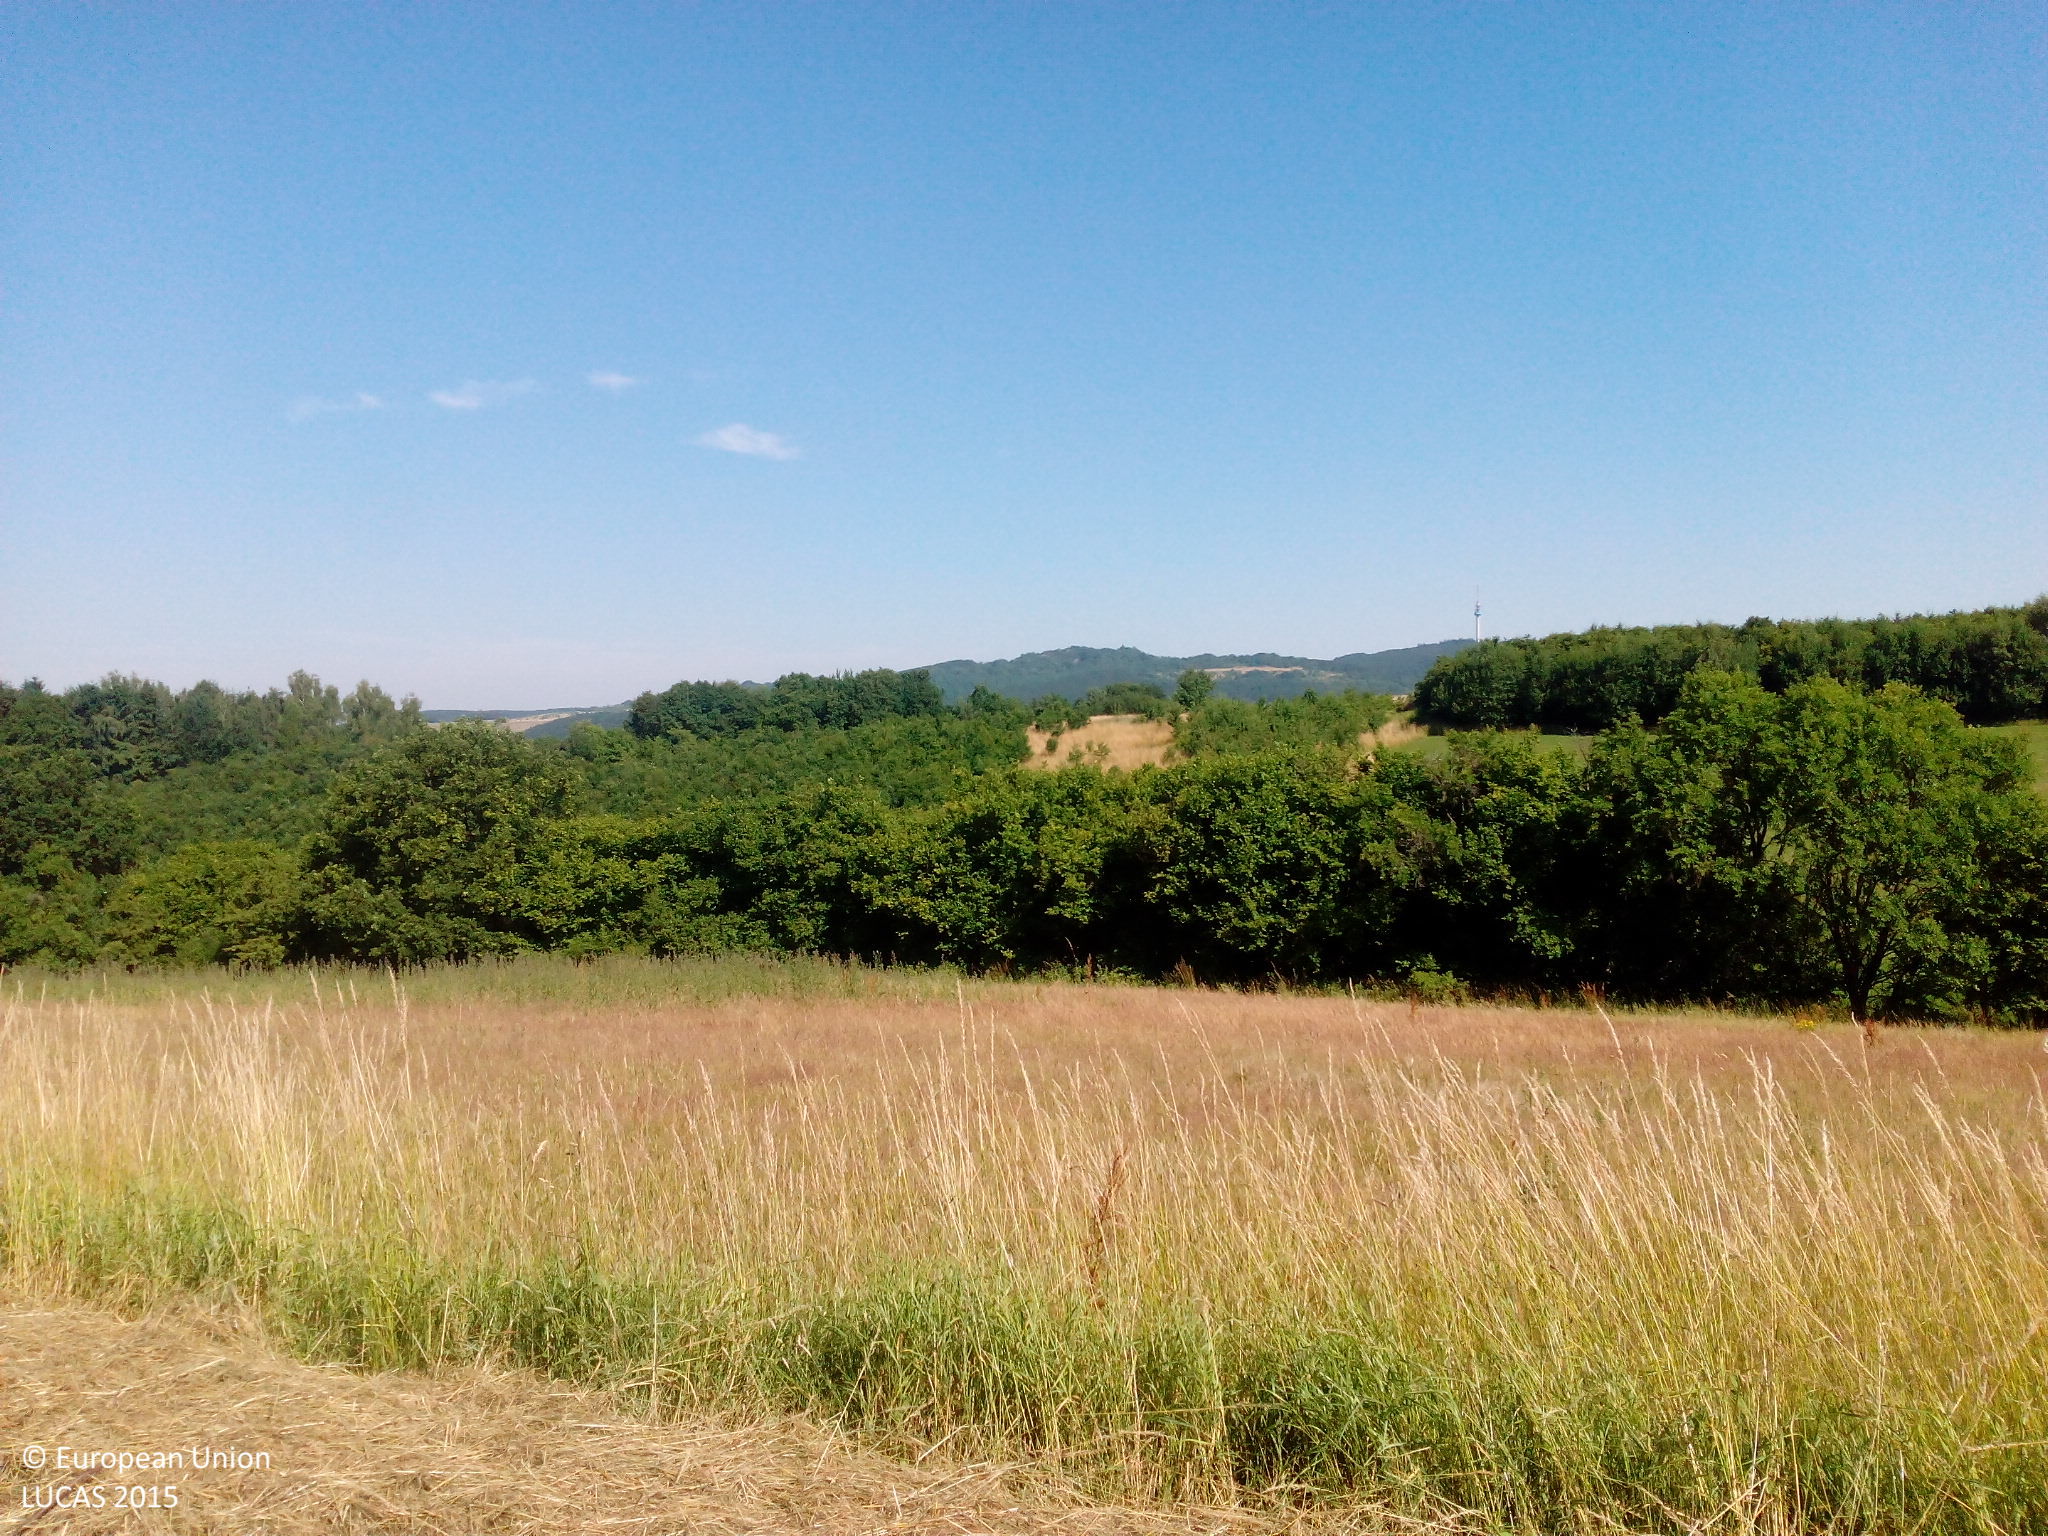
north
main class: Woodland
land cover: Broadleaved woodland
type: acidophilous oak and oak-birch forest
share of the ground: 50 - 75 %
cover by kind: broadleaved forest trees 60 %, shrubs 40 %
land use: Abandoned areas
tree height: < 5 m
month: July
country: DE
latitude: 49.5283
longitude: 7.5550
